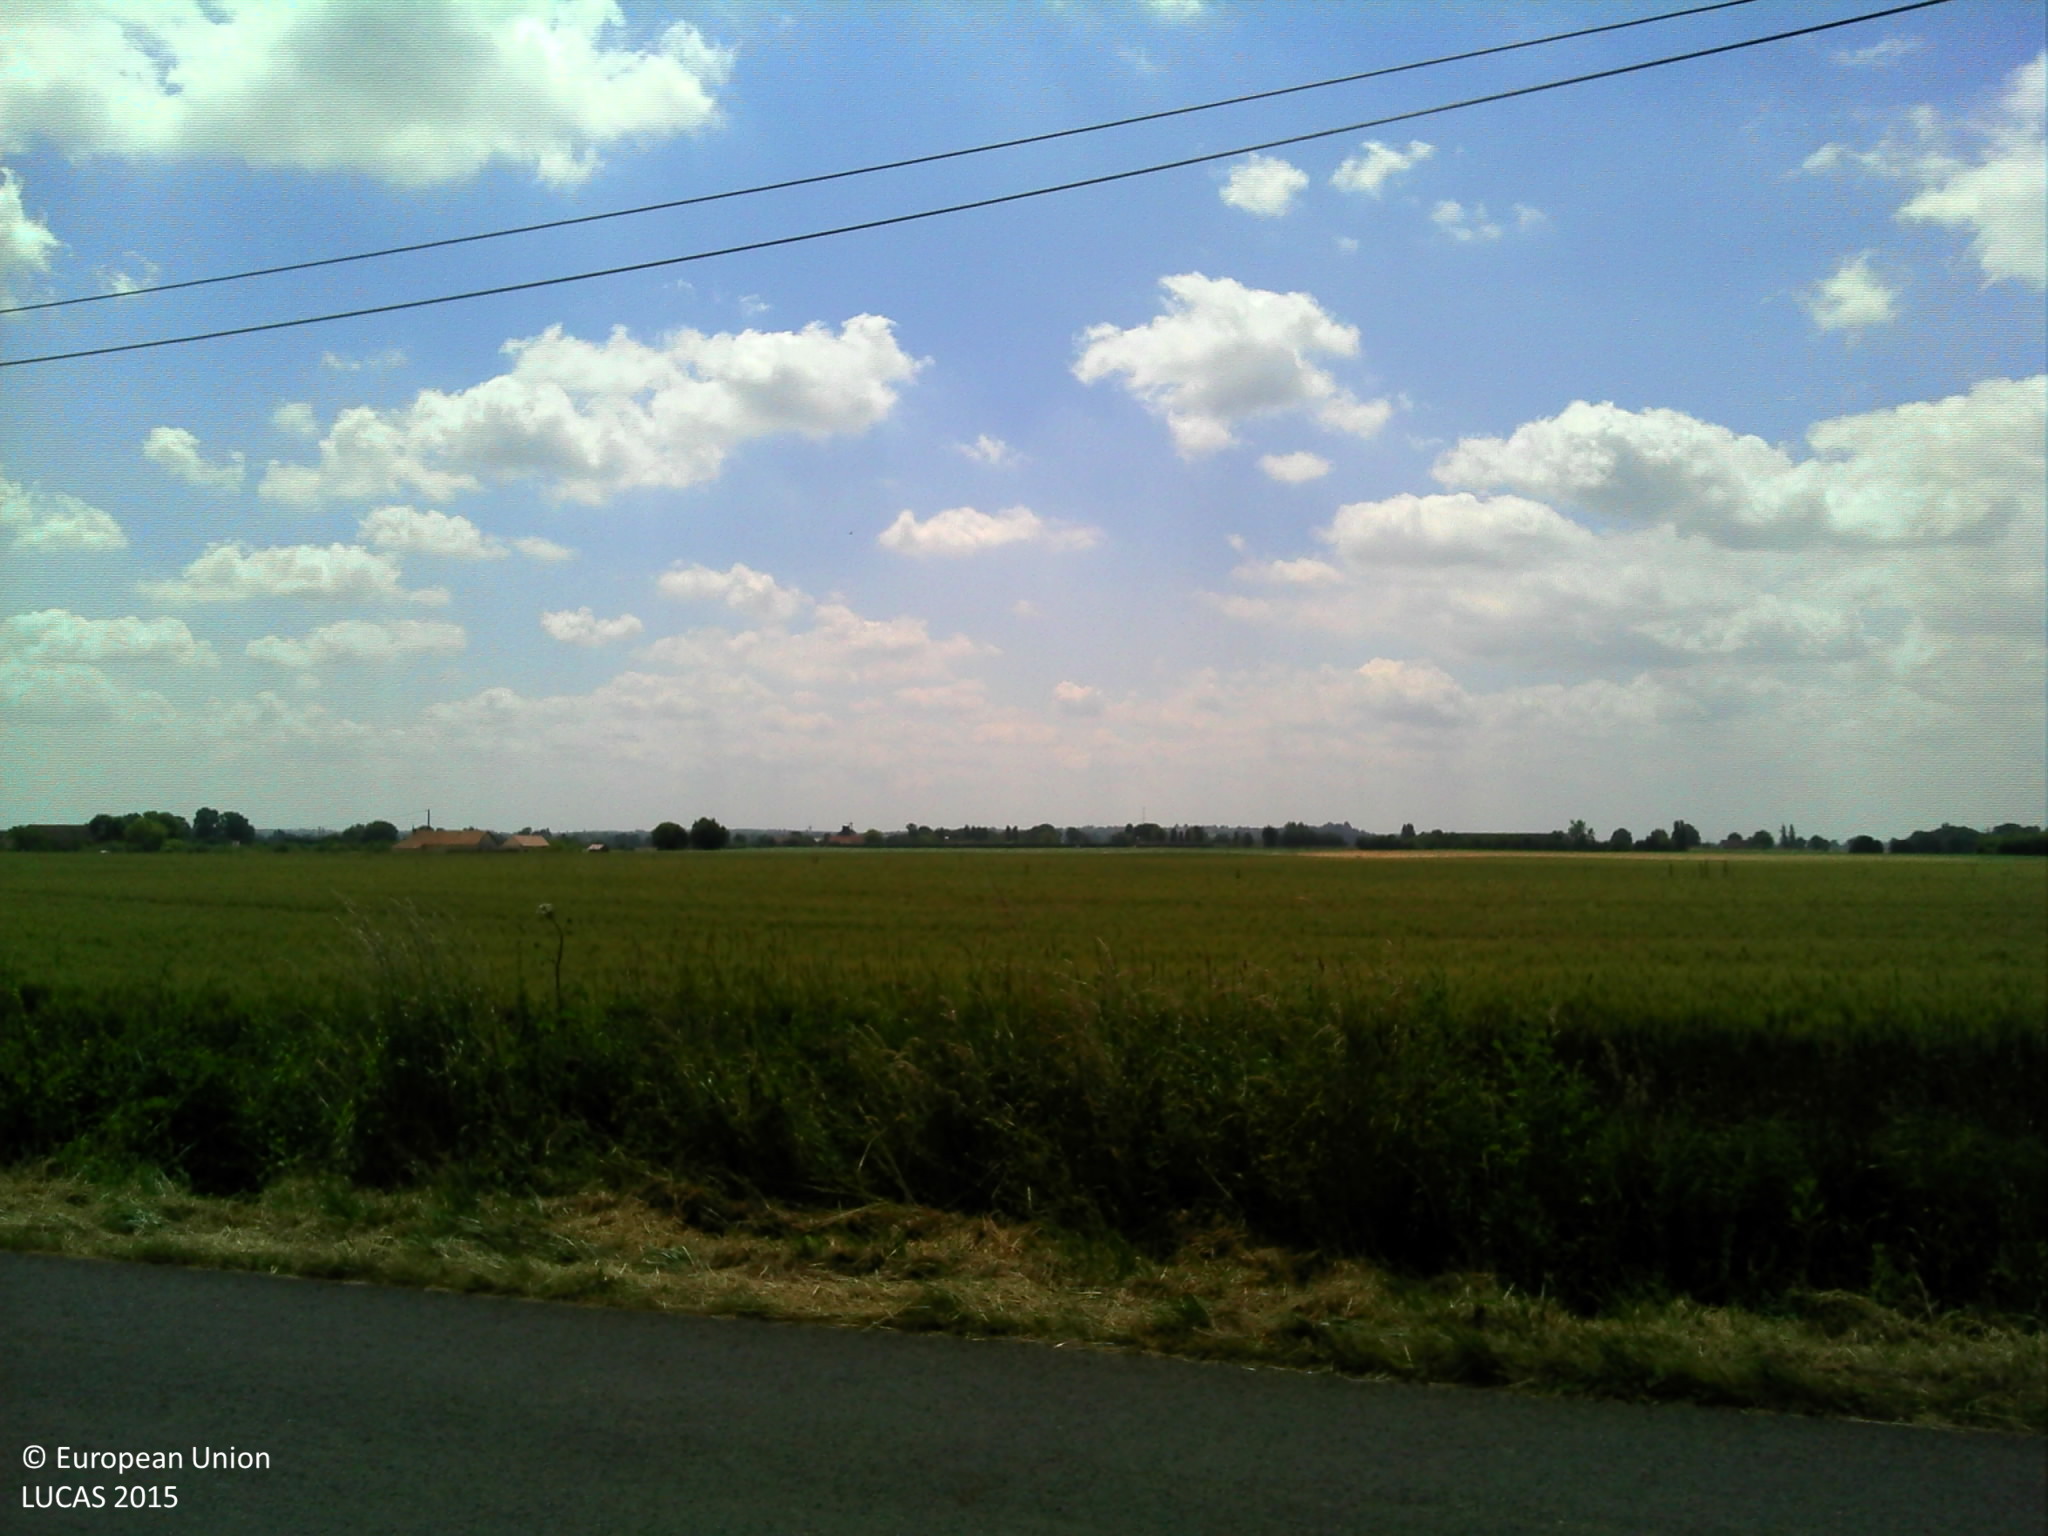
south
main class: Cropland
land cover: Common wheat
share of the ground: > 75 %
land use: Agriculture (excluding fallow land and kitchen gardens)
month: June
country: FR
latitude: 48.2246
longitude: 0.2413
